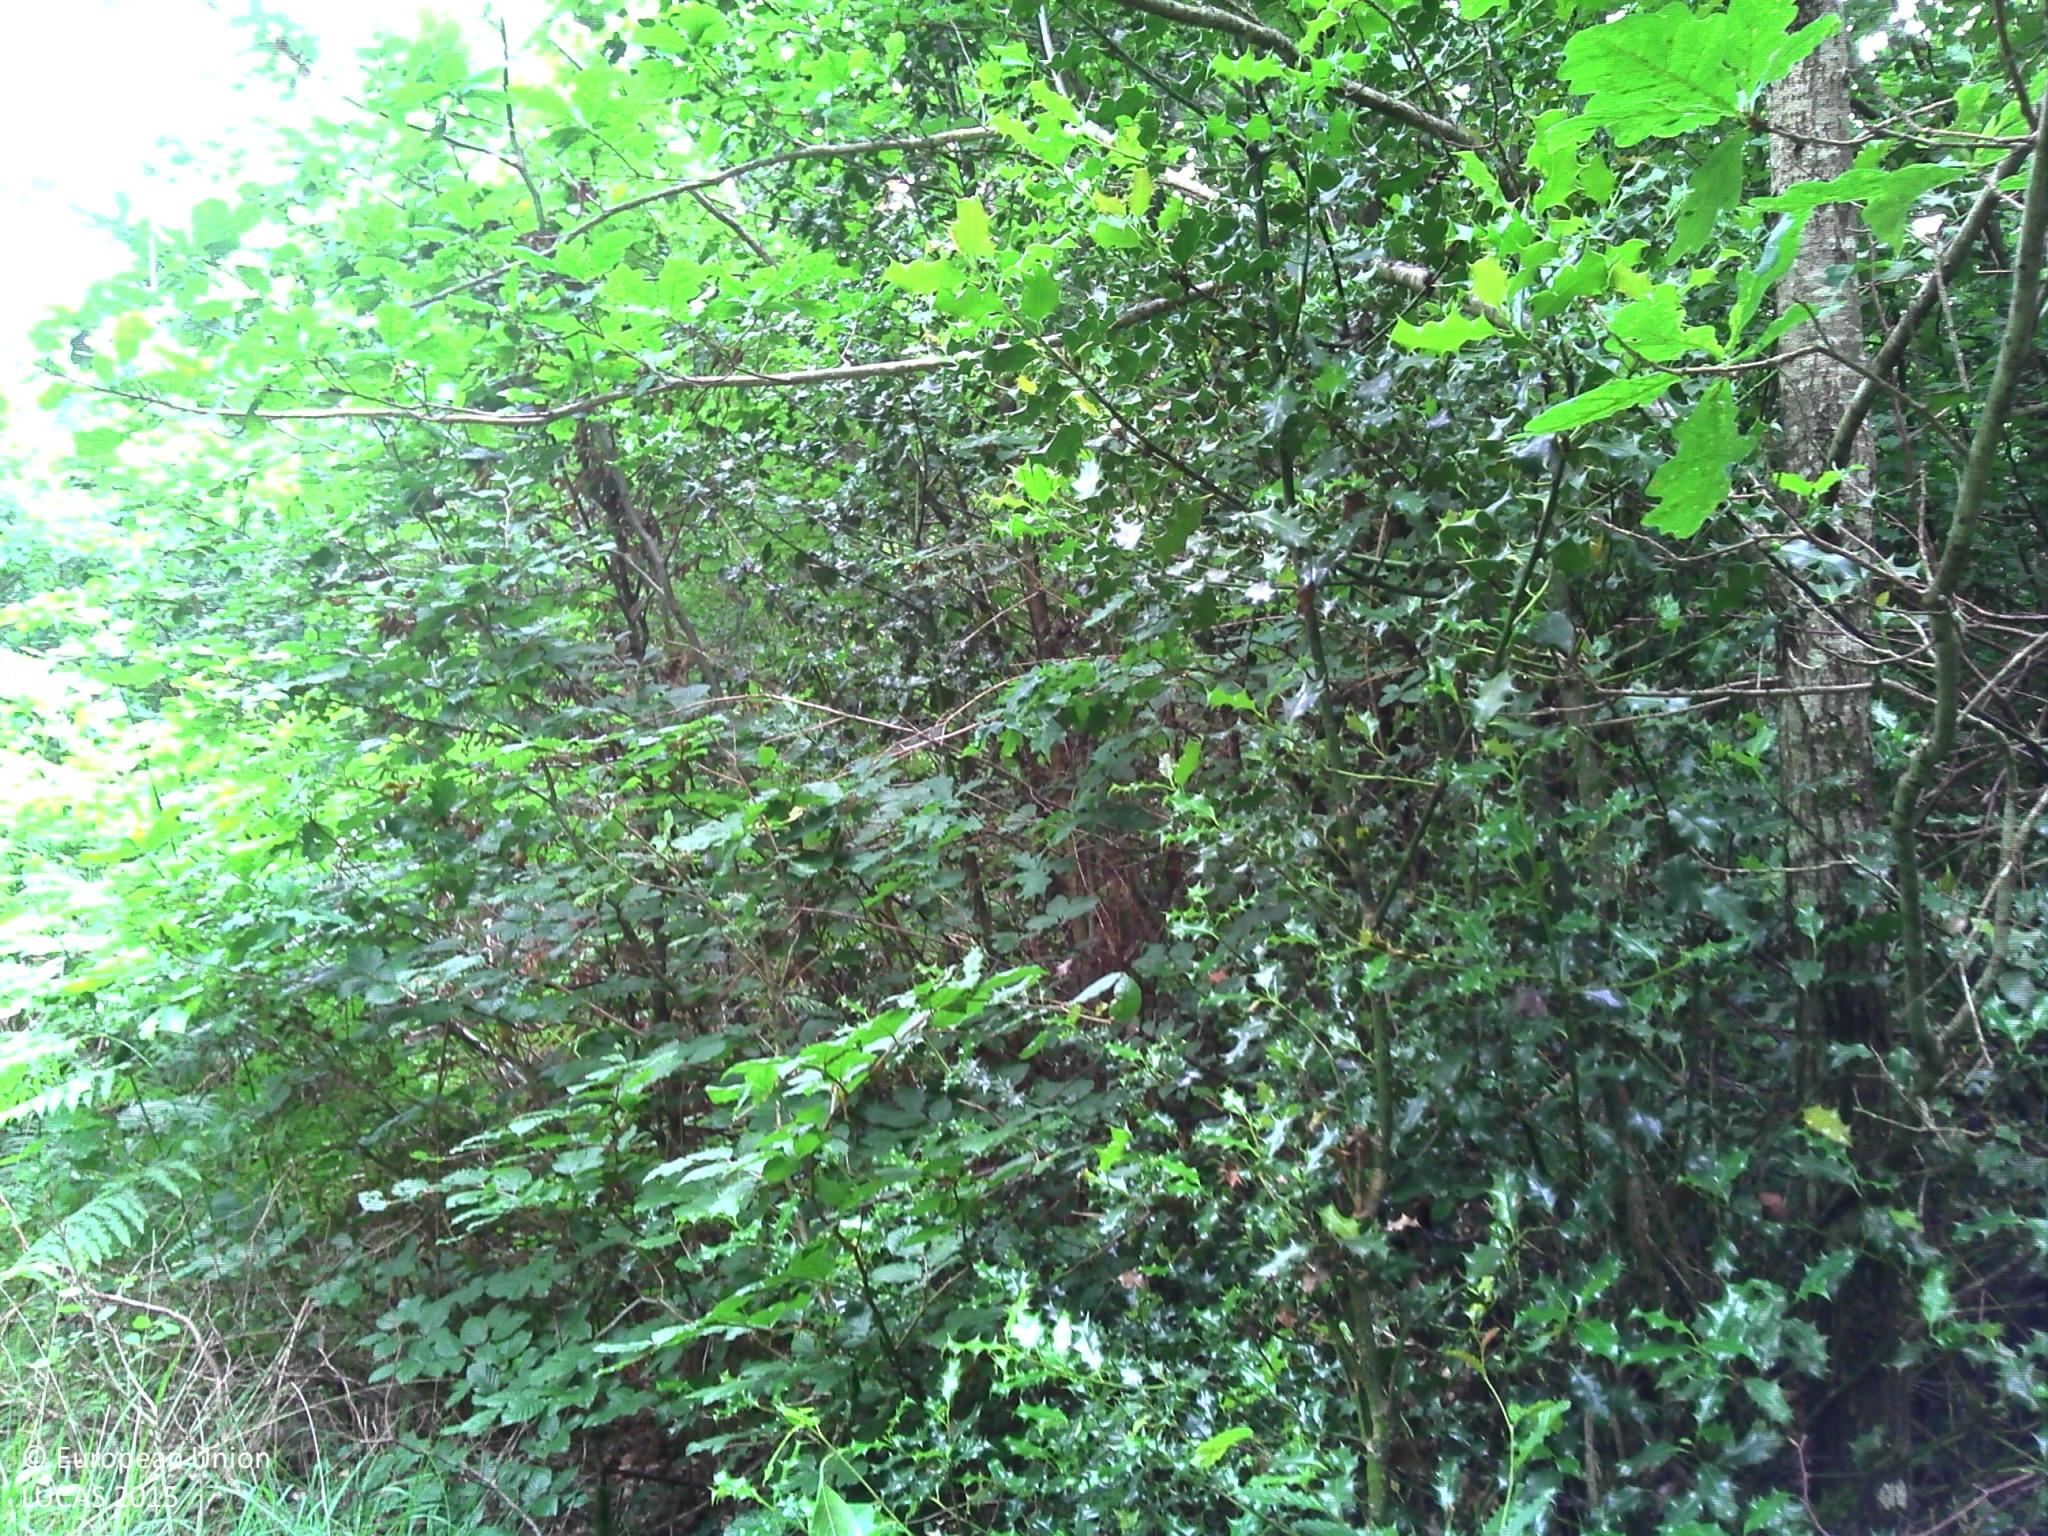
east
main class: Woodland
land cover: Broadleaved woodland
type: acidophilous oak and oak-birch forest
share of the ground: > 75 %
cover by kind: broadleaved forest trees 90 %, shrubs 10 %
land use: Forestry
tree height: > 5 m
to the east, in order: Broadleaved woodland; Rivers and streams; Tracks; Rivers and streams; Broadleaved woodland
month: June
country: FR
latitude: 46.6435
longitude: 2.6923
